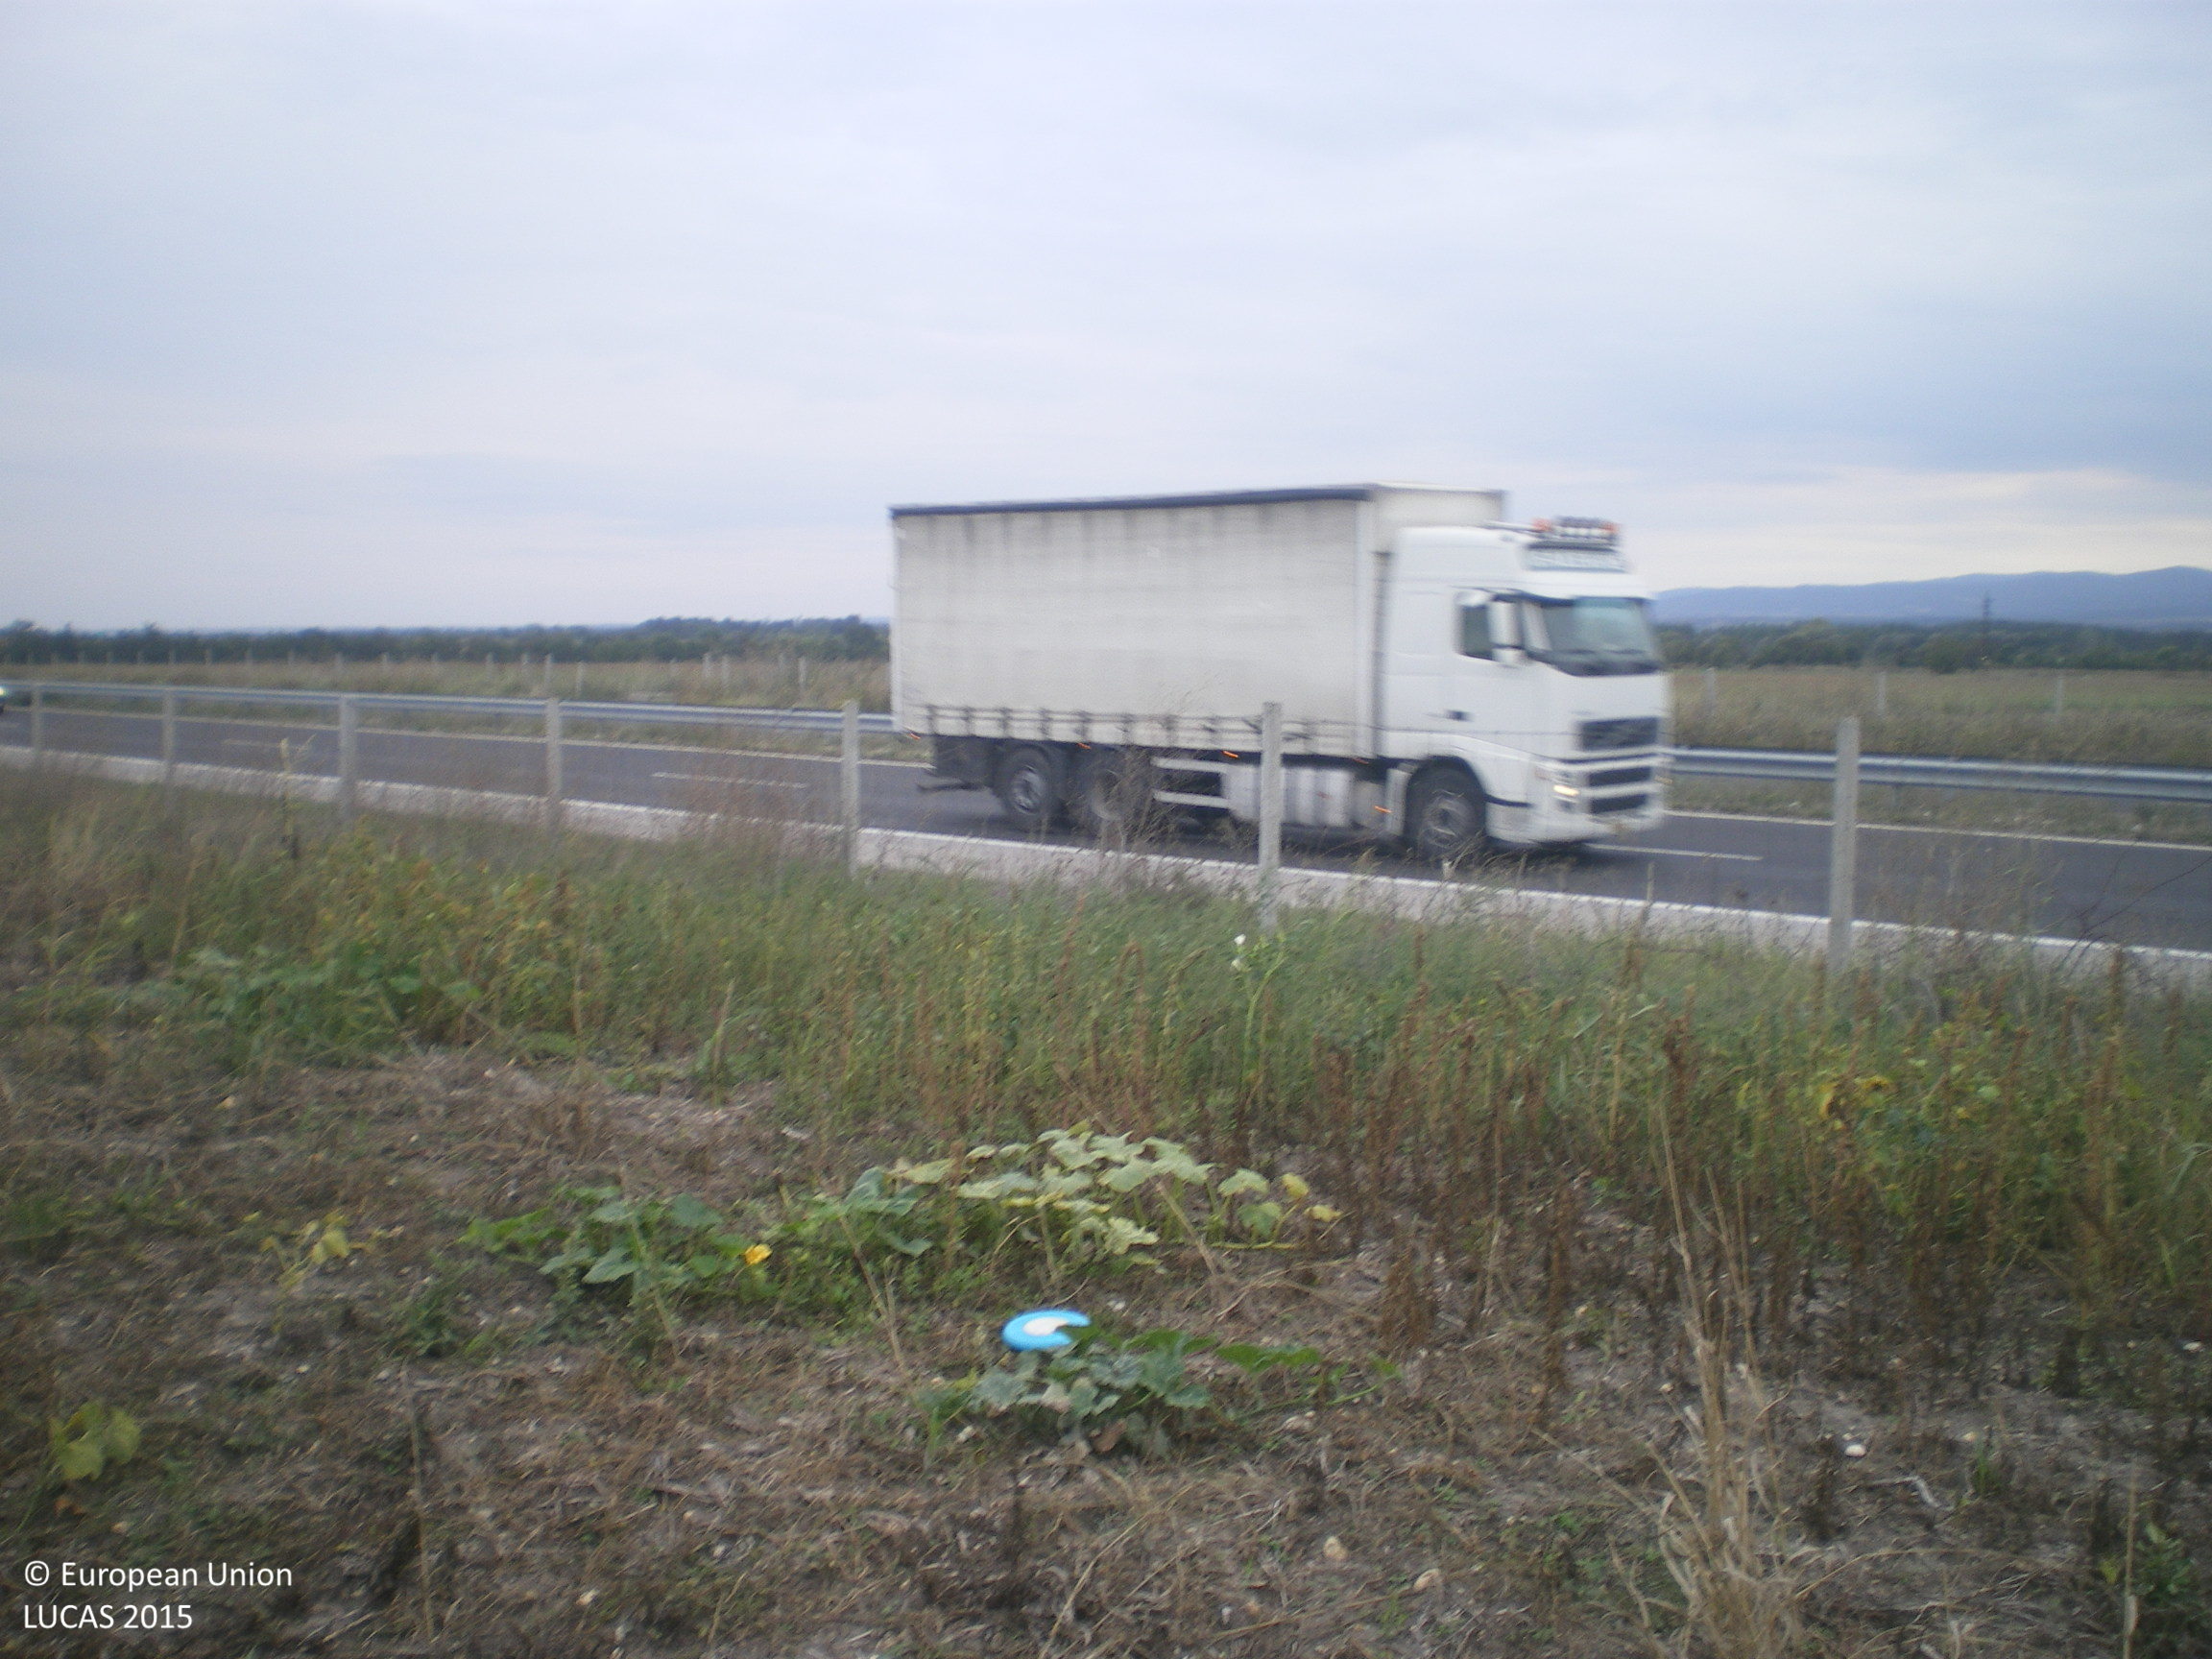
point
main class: Cropland
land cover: Other fresh vegetables
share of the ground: 10 - 25 %
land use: Agriculture (excluding fallow land and kitchen gardens)
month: October
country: BG
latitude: 41.8261
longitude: 26.1489
